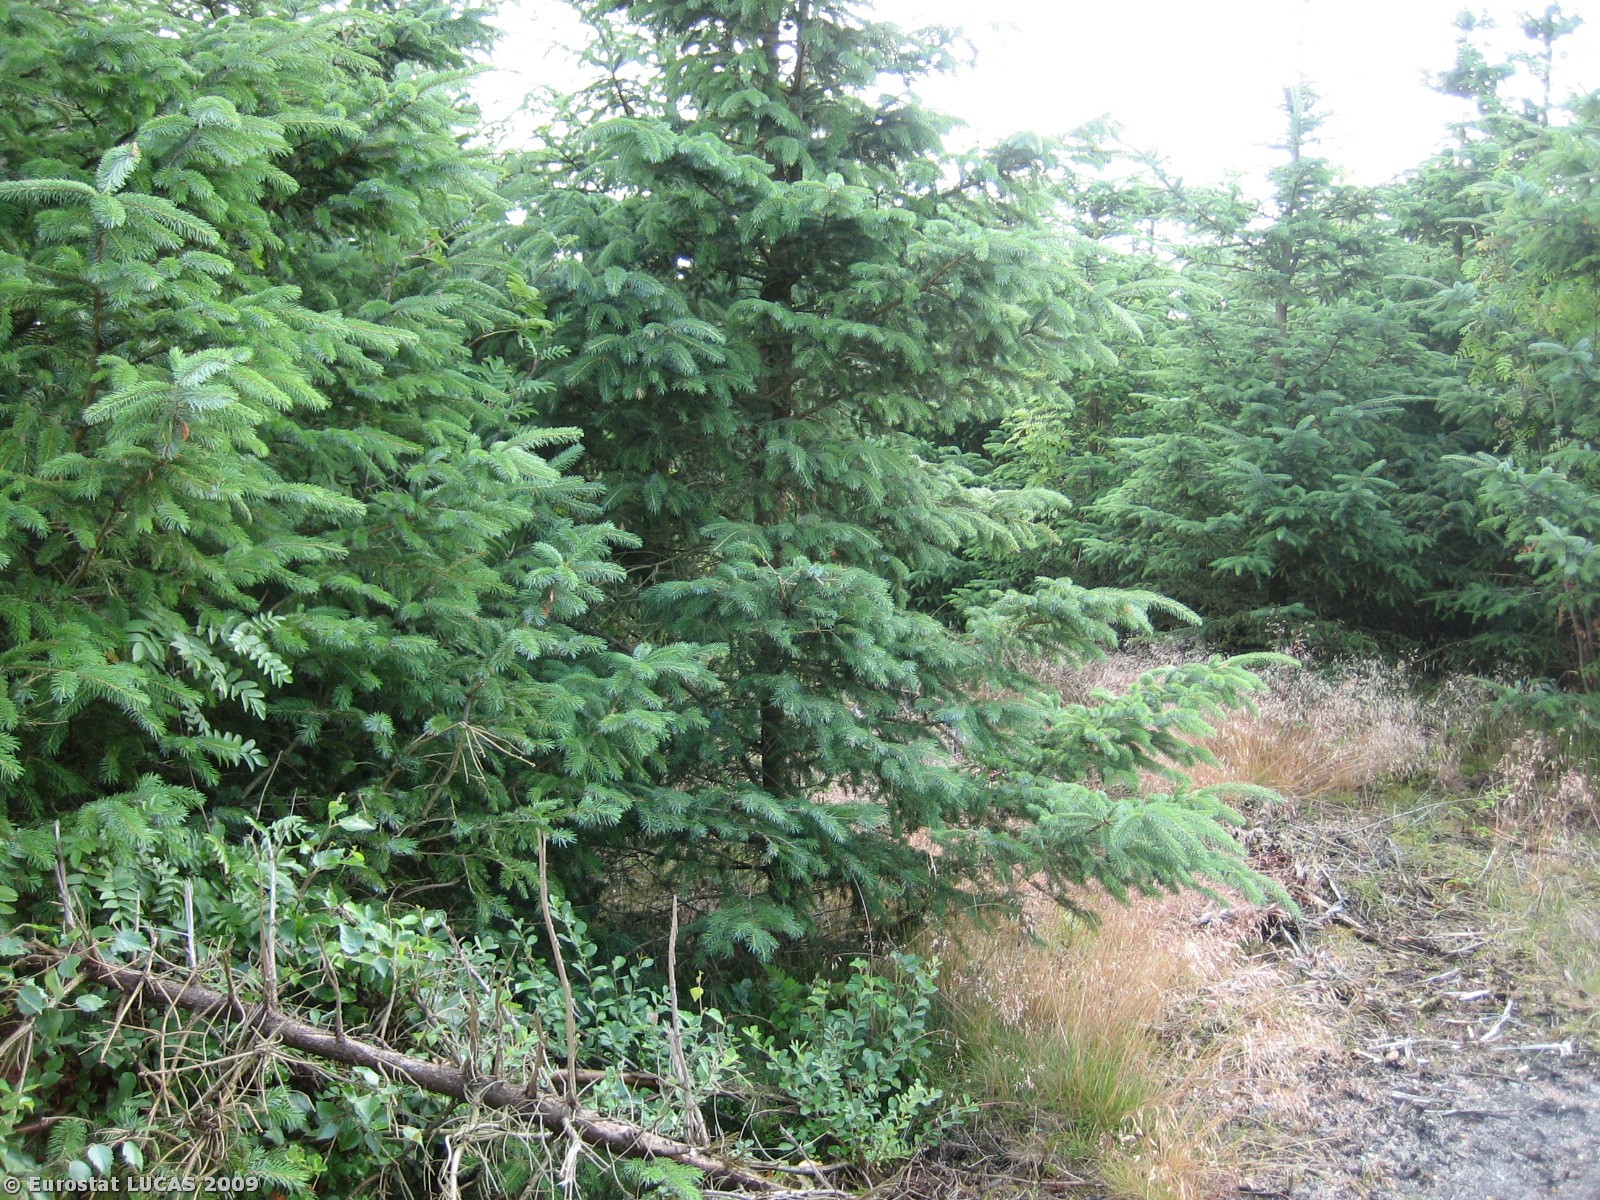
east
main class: Woodland
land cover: Coniferous woodland
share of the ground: > 75 %
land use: Forestry
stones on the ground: < 10 %
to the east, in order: Coniferous woodland; Grass margins; Coniferous woodland; Other structural elements; Mixed woodland; Grass margins; Mixed woodland; Other structural elements; Broadleaved woodland; Grass margins; Coniferous woodland; Grass margins; Coniferous woodland; Grass margins; Broadleaved woodland; Tracks; Single bushes/trees; Tracks; Coniferous woodland; Broadleaved woodland; Mixed woodland
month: July
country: DK
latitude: 55.5653
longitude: 8.3048
